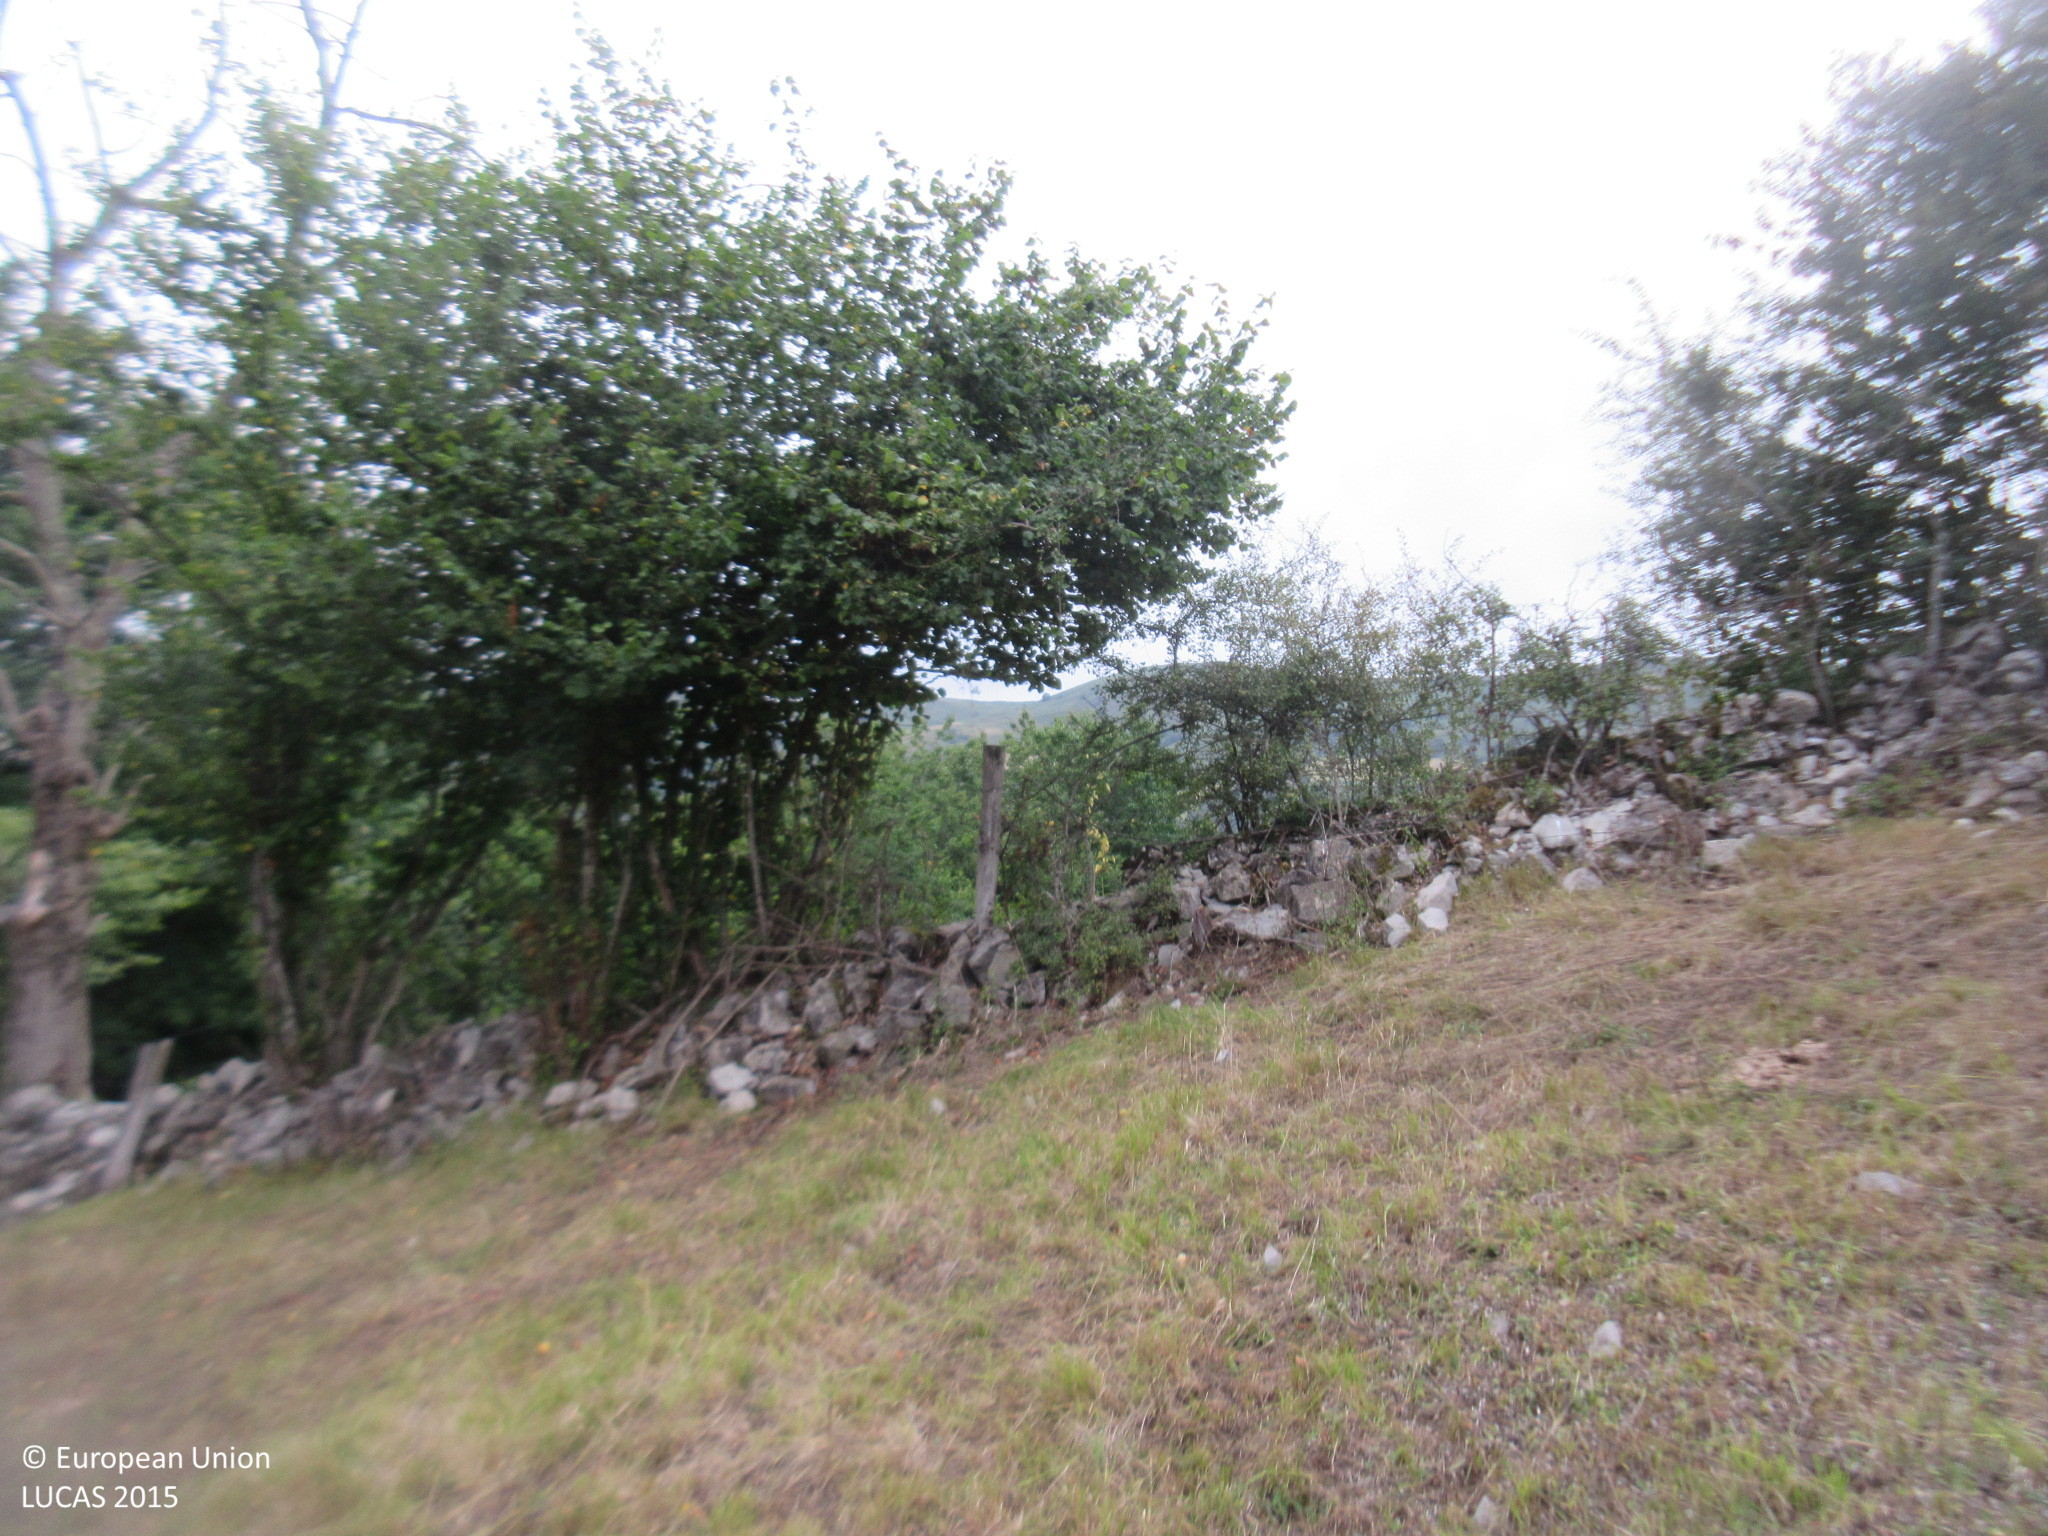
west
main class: Grassland
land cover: Grassland without tree/shrub cover
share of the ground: > 75 %
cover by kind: herbaceous plants 100 %
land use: Agriculture (excluding fallow land and kitchen gardens)
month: July
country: ES
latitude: 43.2136
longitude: -3.9965
